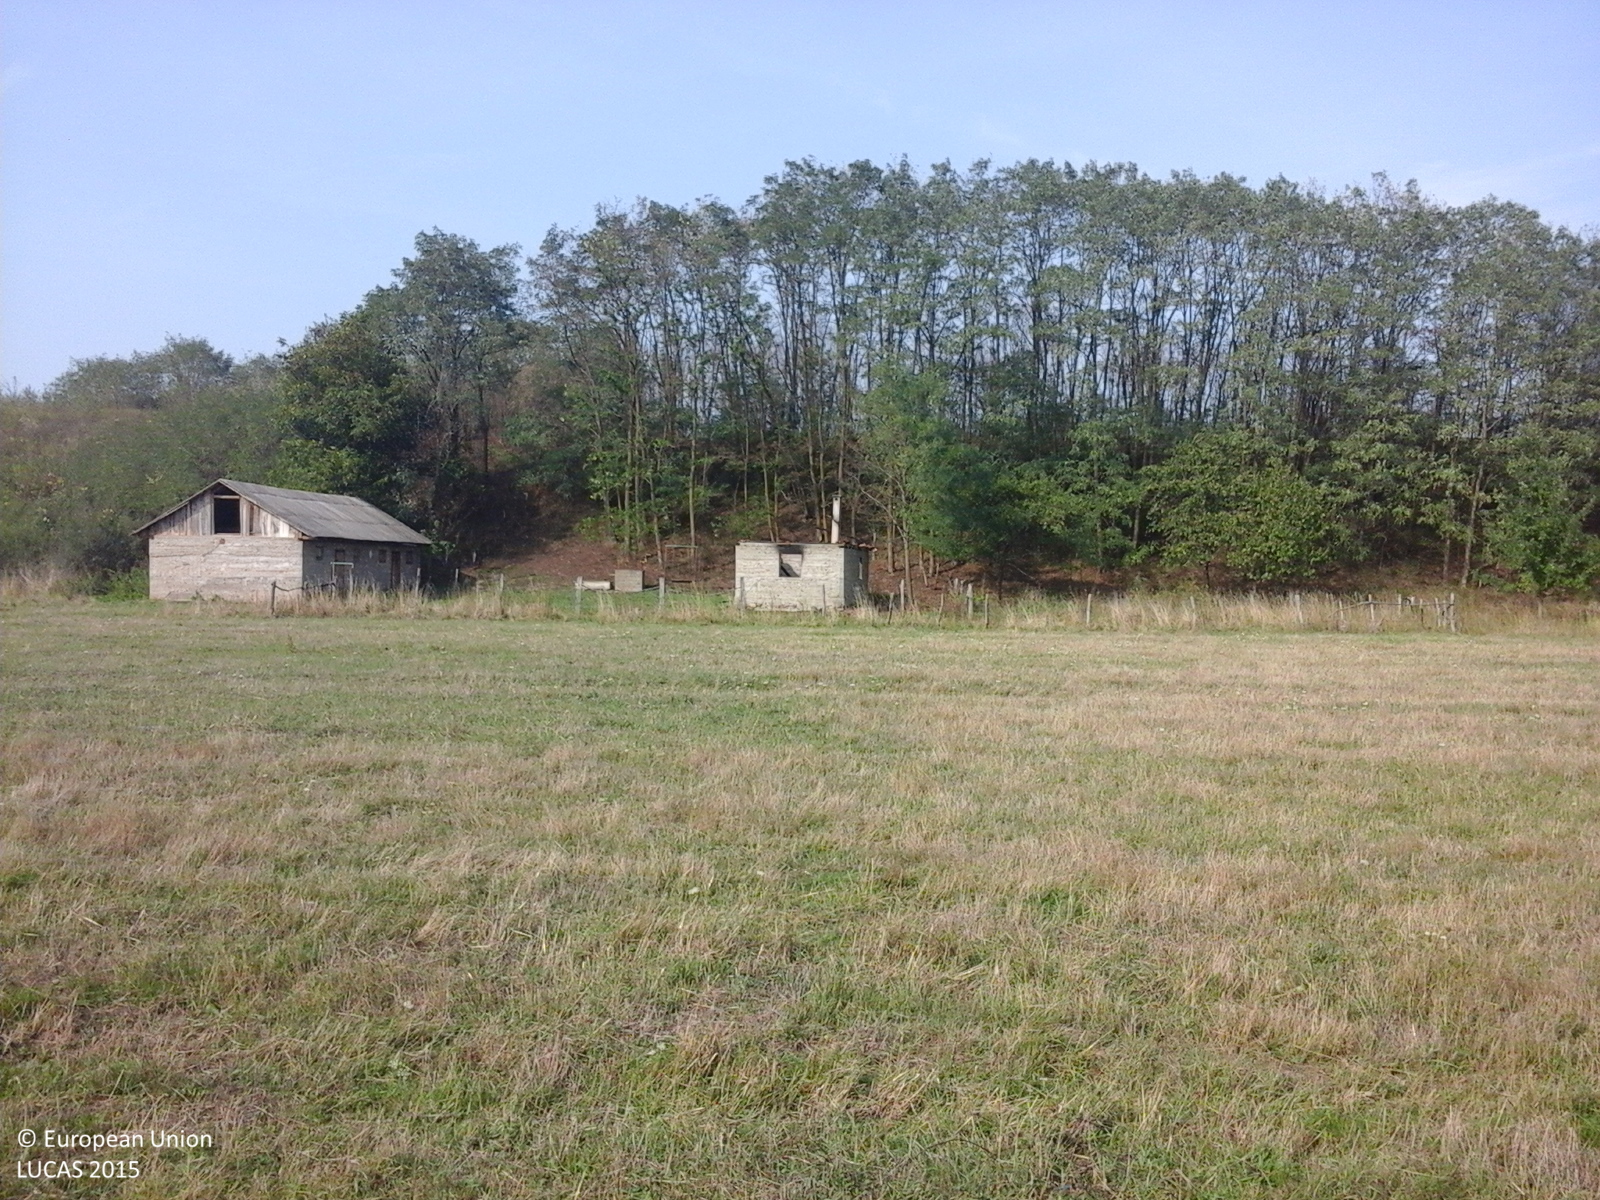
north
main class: Grassland
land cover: Grassland without tree/shrub cover
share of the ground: > 75 %
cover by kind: herbaceous plants 100 %
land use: Agriculture (excluding fallow land and kitchen gardens)
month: September
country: RO
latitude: 45.4850
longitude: 22.2085
